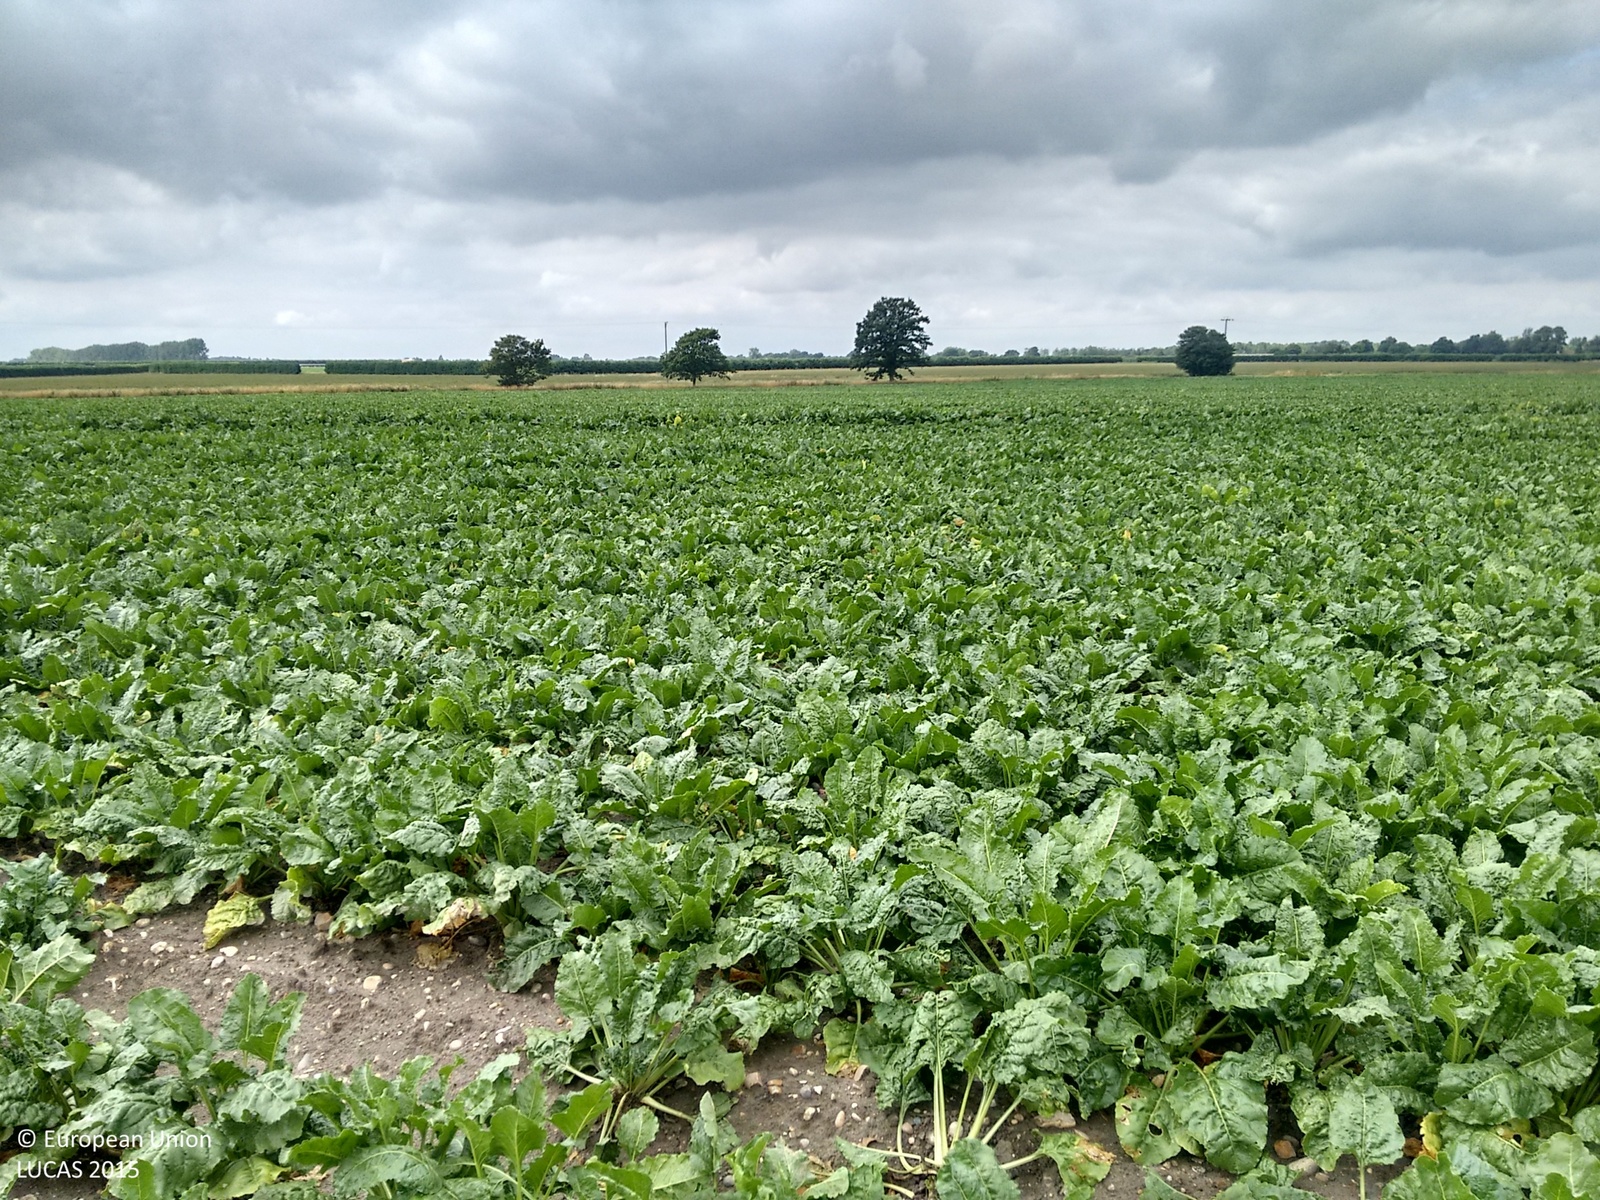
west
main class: Cropland
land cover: Sugar beet
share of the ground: > 75 %
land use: Agriculture (excluding fallow land and kitchen gardens)
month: August
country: GB
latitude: 51.9402
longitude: 0.9429
